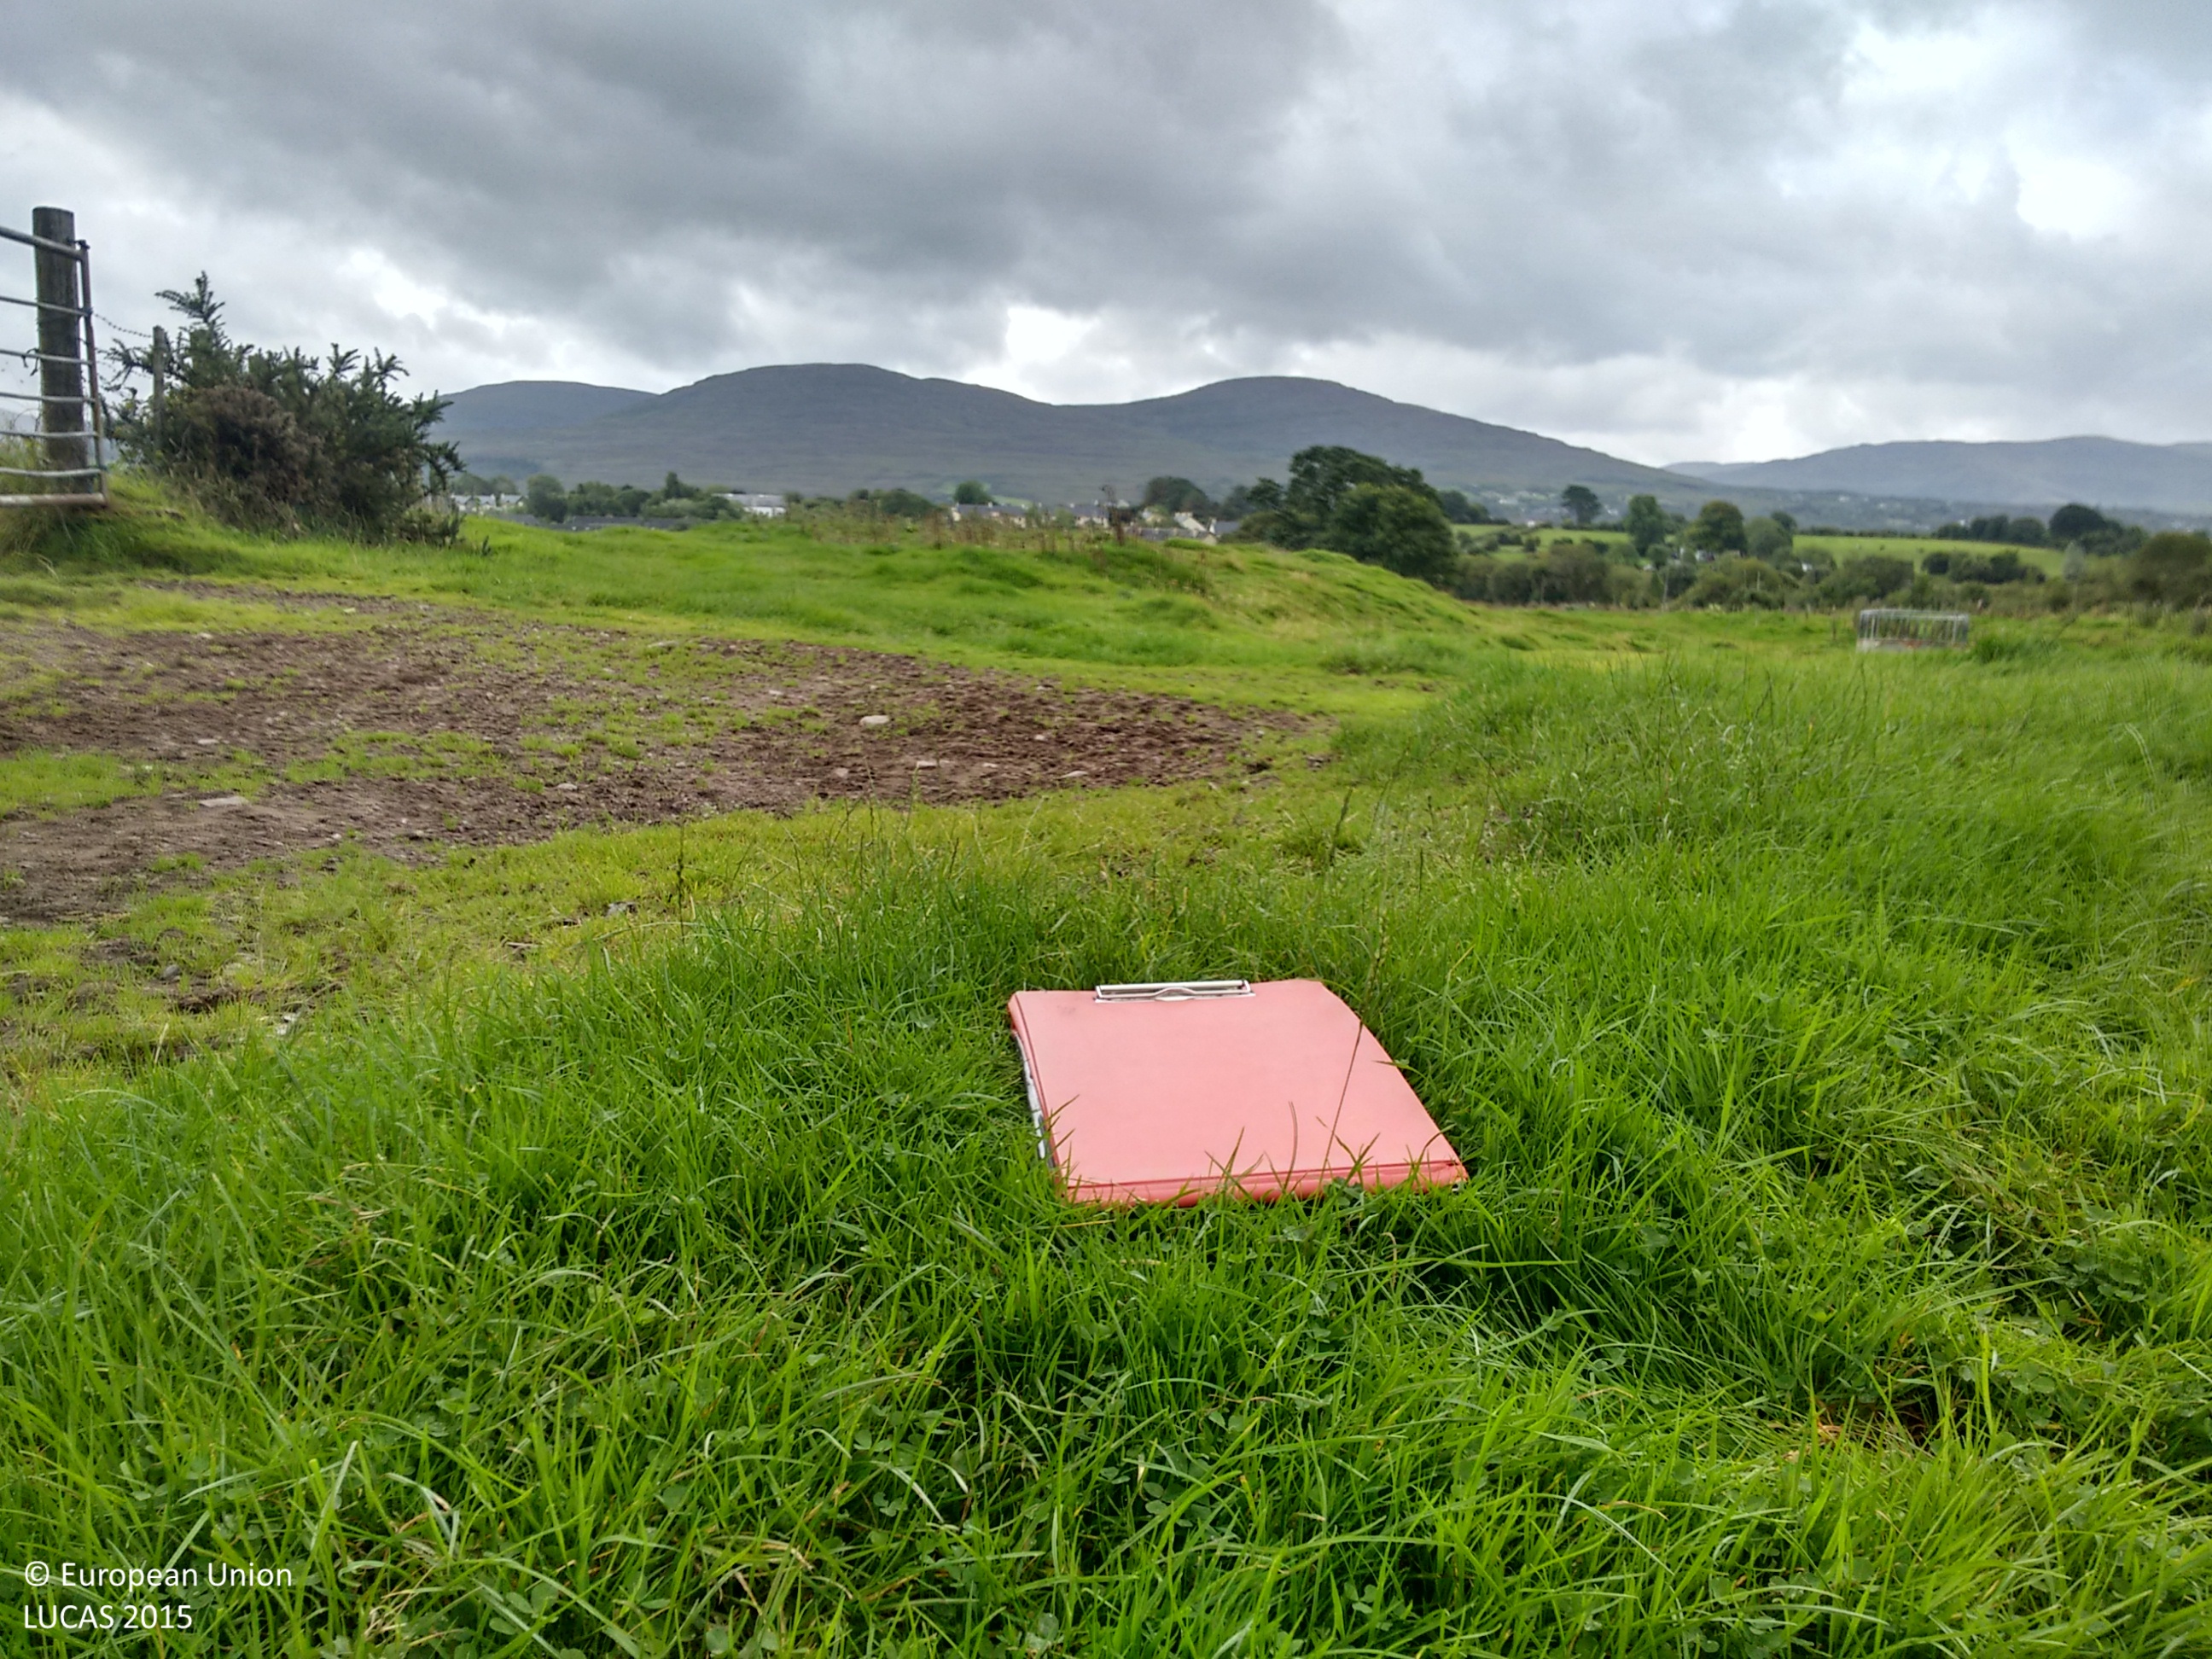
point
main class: Grassland
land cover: Grassland without tree/shrub cover
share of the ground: > 75 %
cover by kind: herbaceous plants 95 %, shrubs 5 %
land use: Agriculture (excluding fallow land and kitchen gardens)
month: August
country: IE
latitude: 51.8861
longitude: -9.6042
